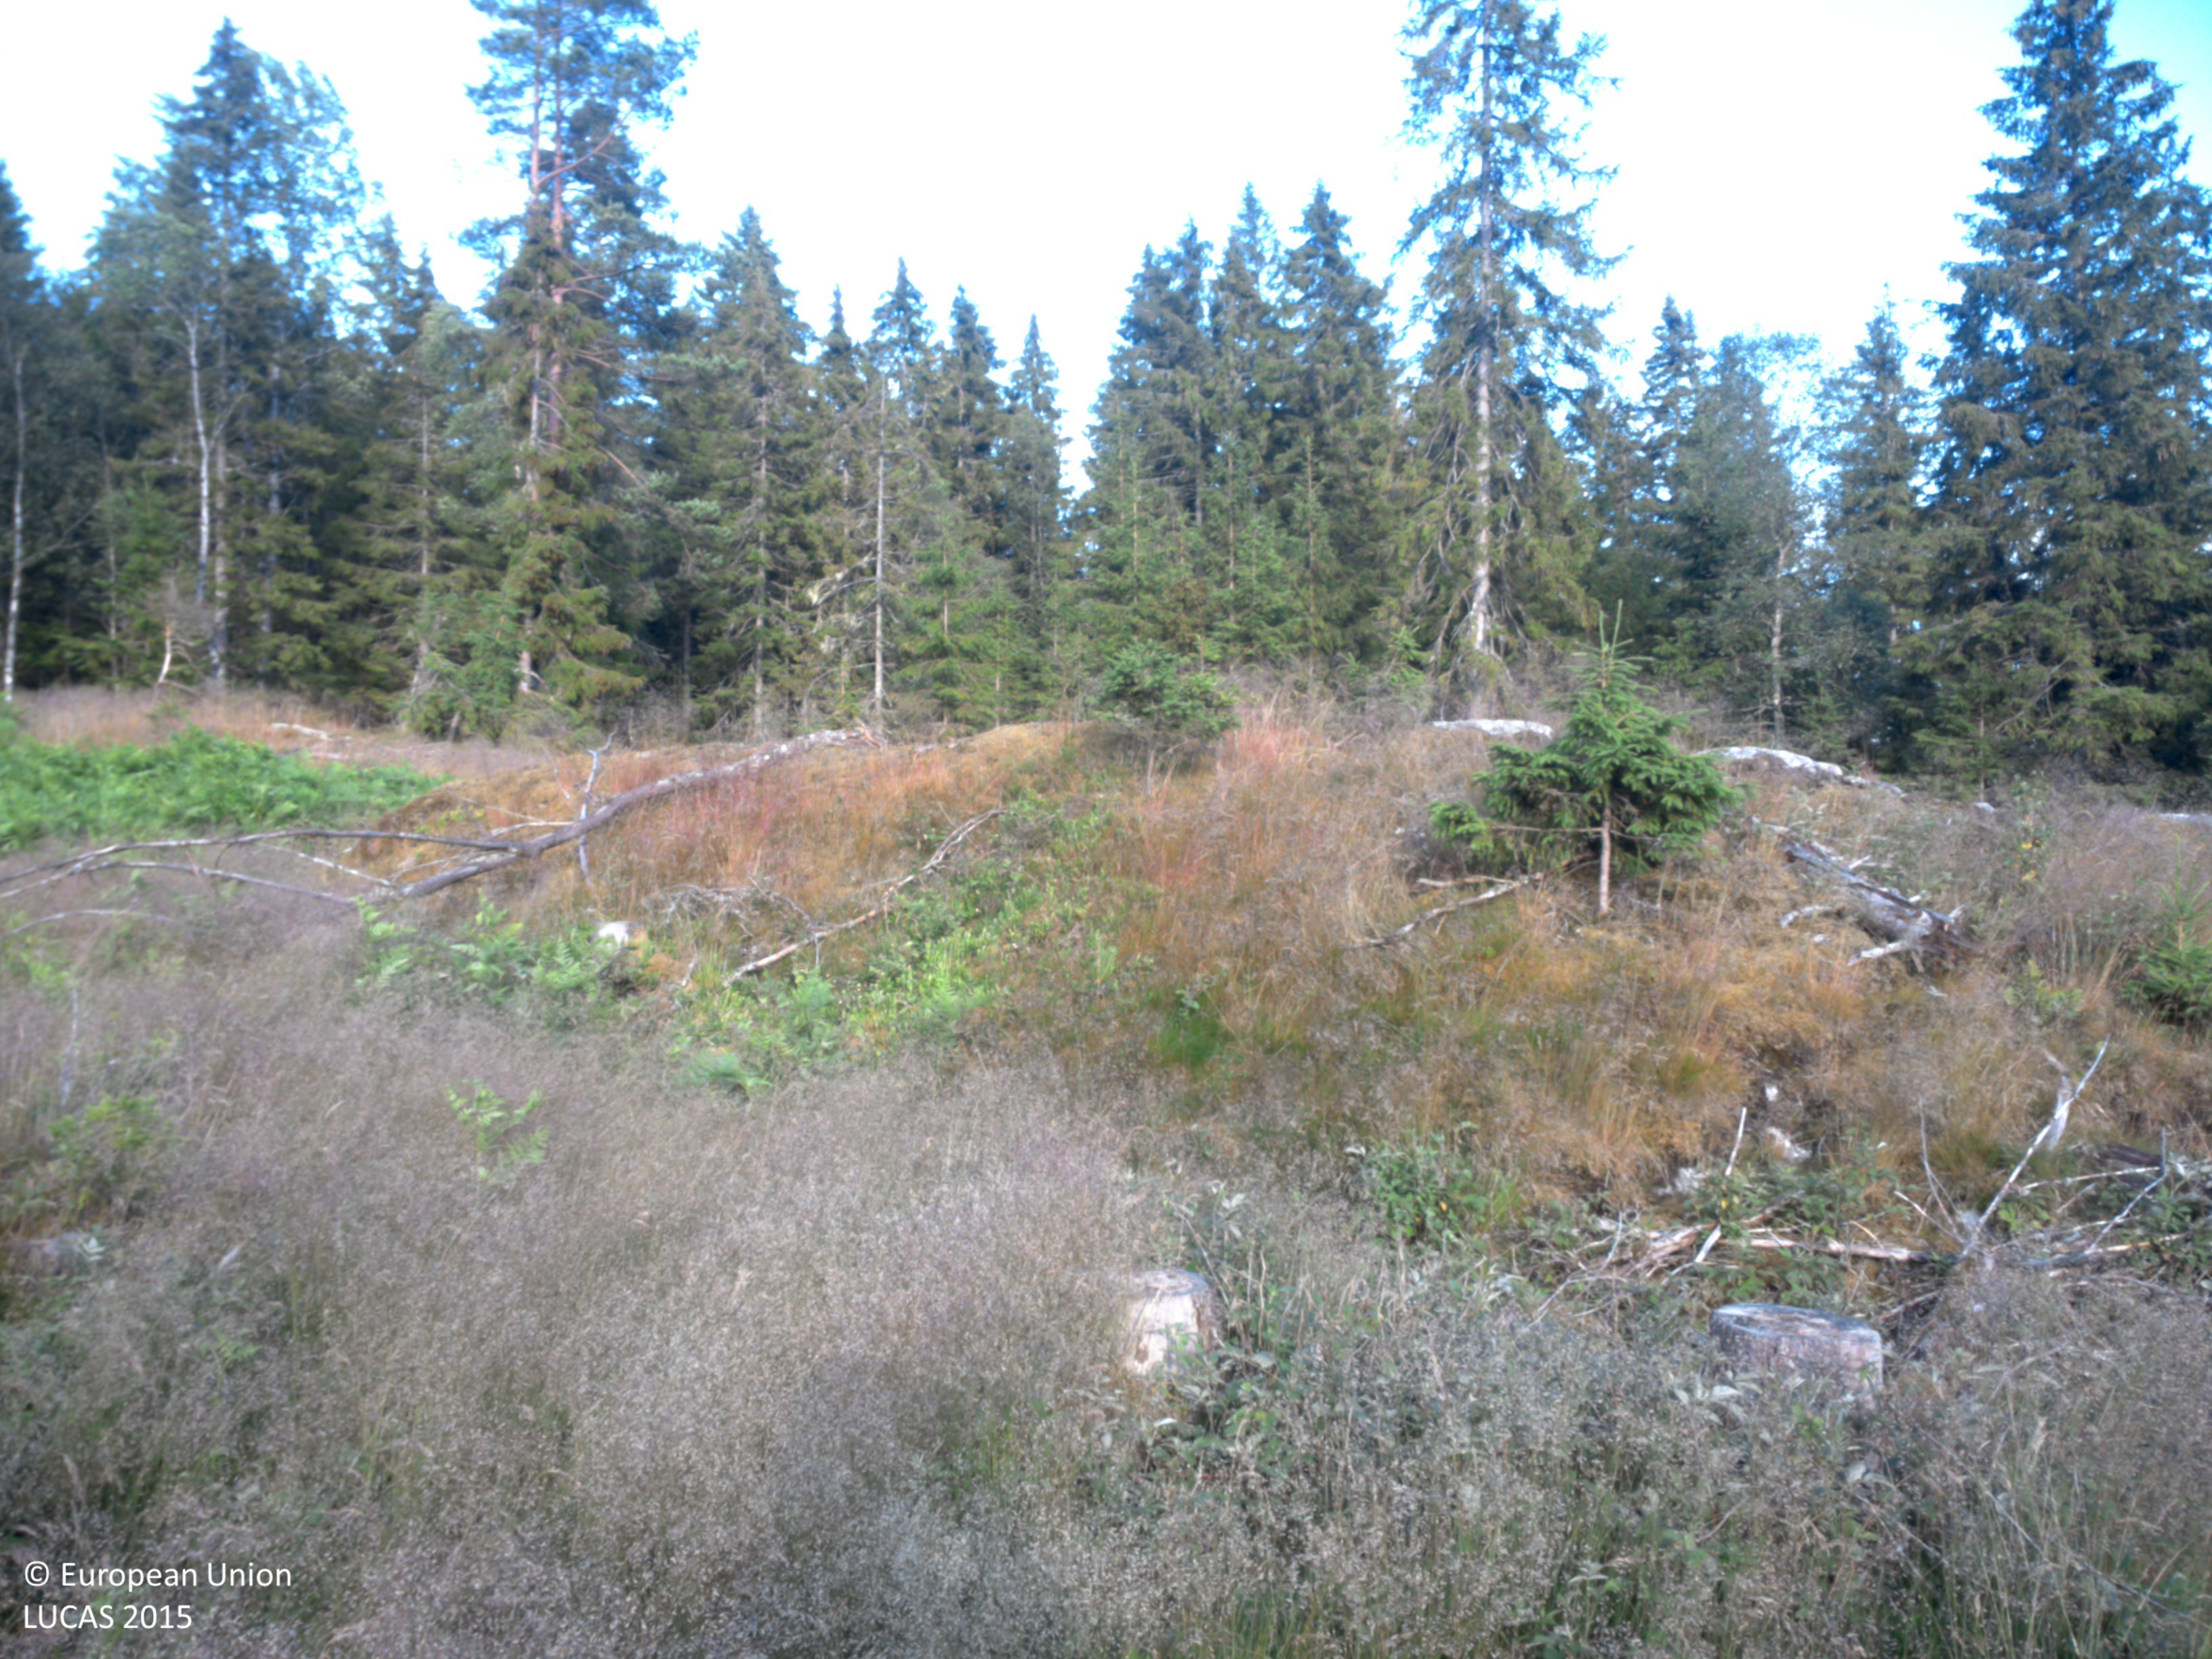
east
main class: Grassland
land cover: Grassland with sparse tree/shrub cover
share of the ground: 25 - 50 %
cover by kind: herbaceous plants 95 %, coniferous forest trees 5 %
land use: Forestry
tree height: < 5 m
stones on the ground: < 10 %
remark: Clear cut
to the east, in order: Grassland with sparse tree/shrub cover; Spruce dominated coniferous woodland; Rock outcrops; Spruce dominated coniferous woodland; Other coniferous woodland
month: July
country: SE
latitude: 58.8360
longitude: 11.8841
